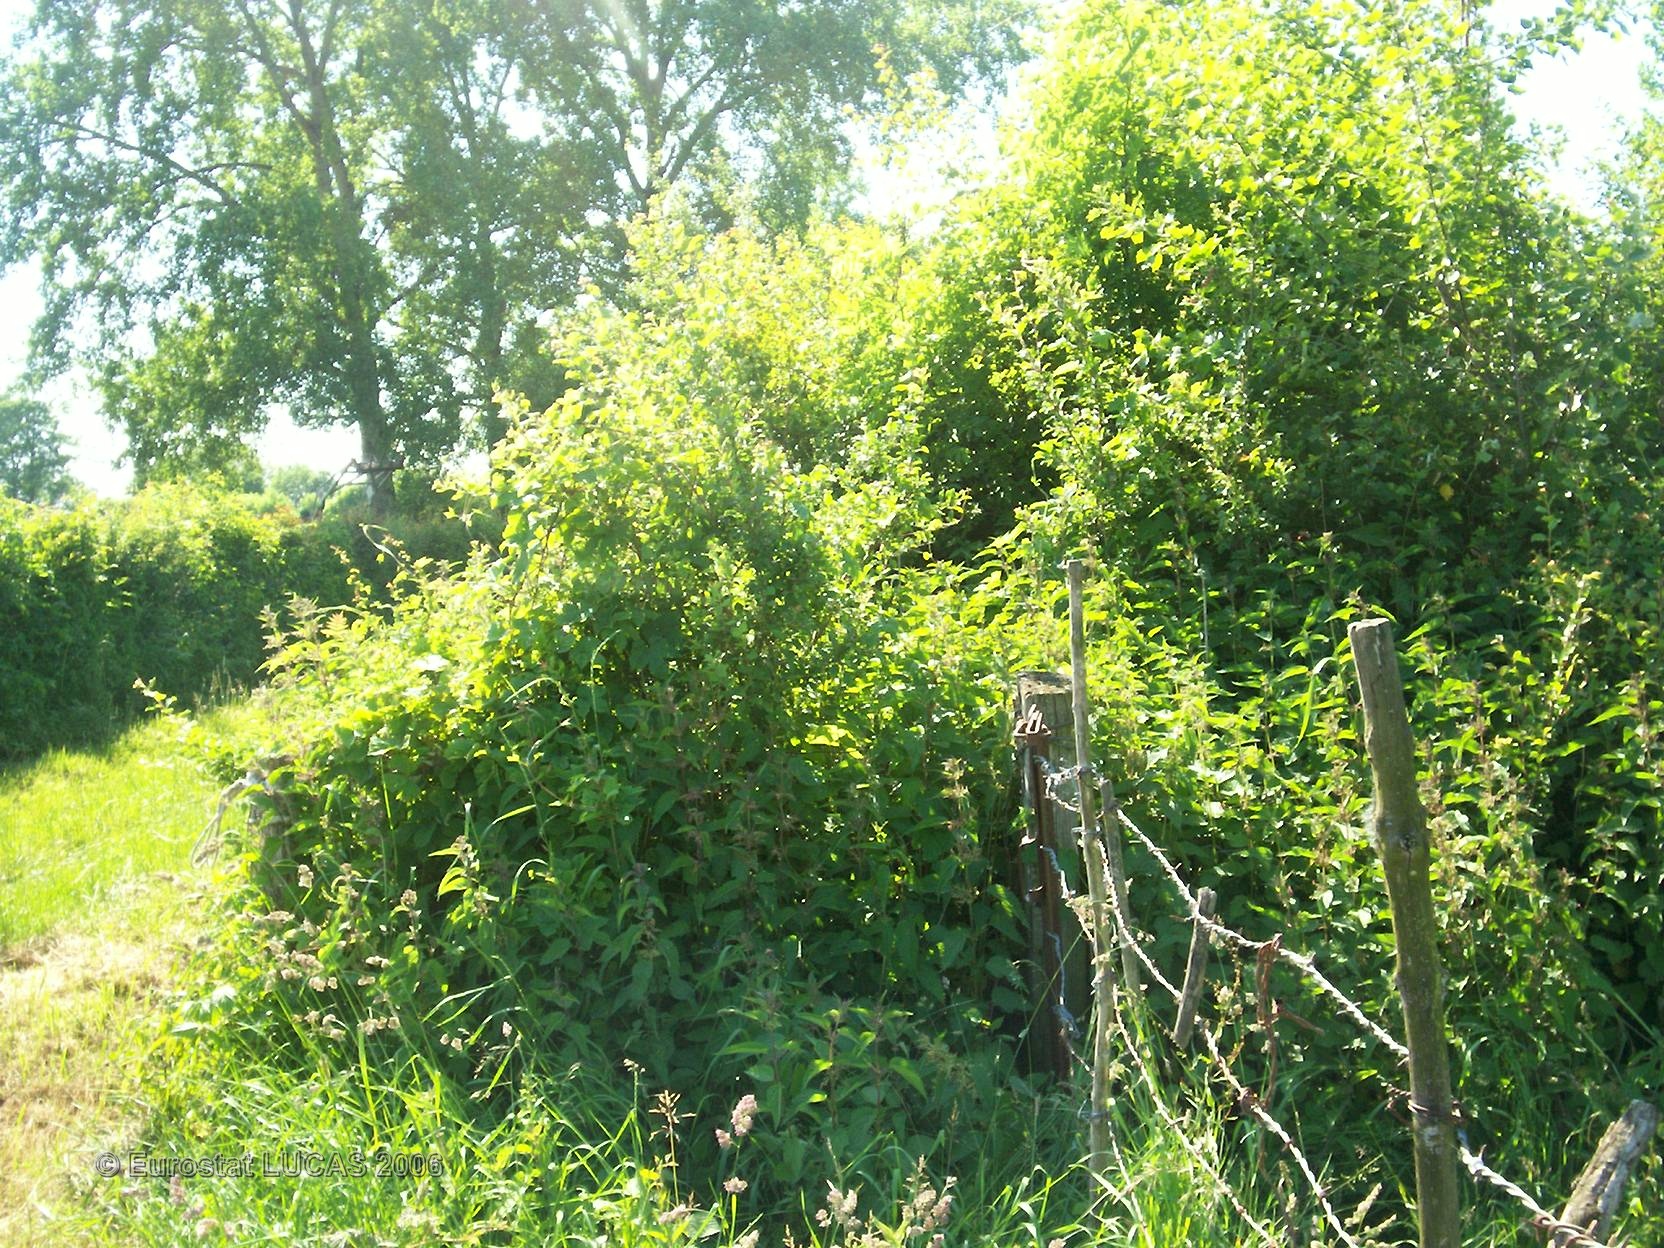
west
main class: Grassland
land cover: Grassland without tree/shrub cover
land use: Agriculture (excluding fallow land and kitchen gardens)
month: June
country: FR
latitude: 48.7416
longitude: 4.6258
